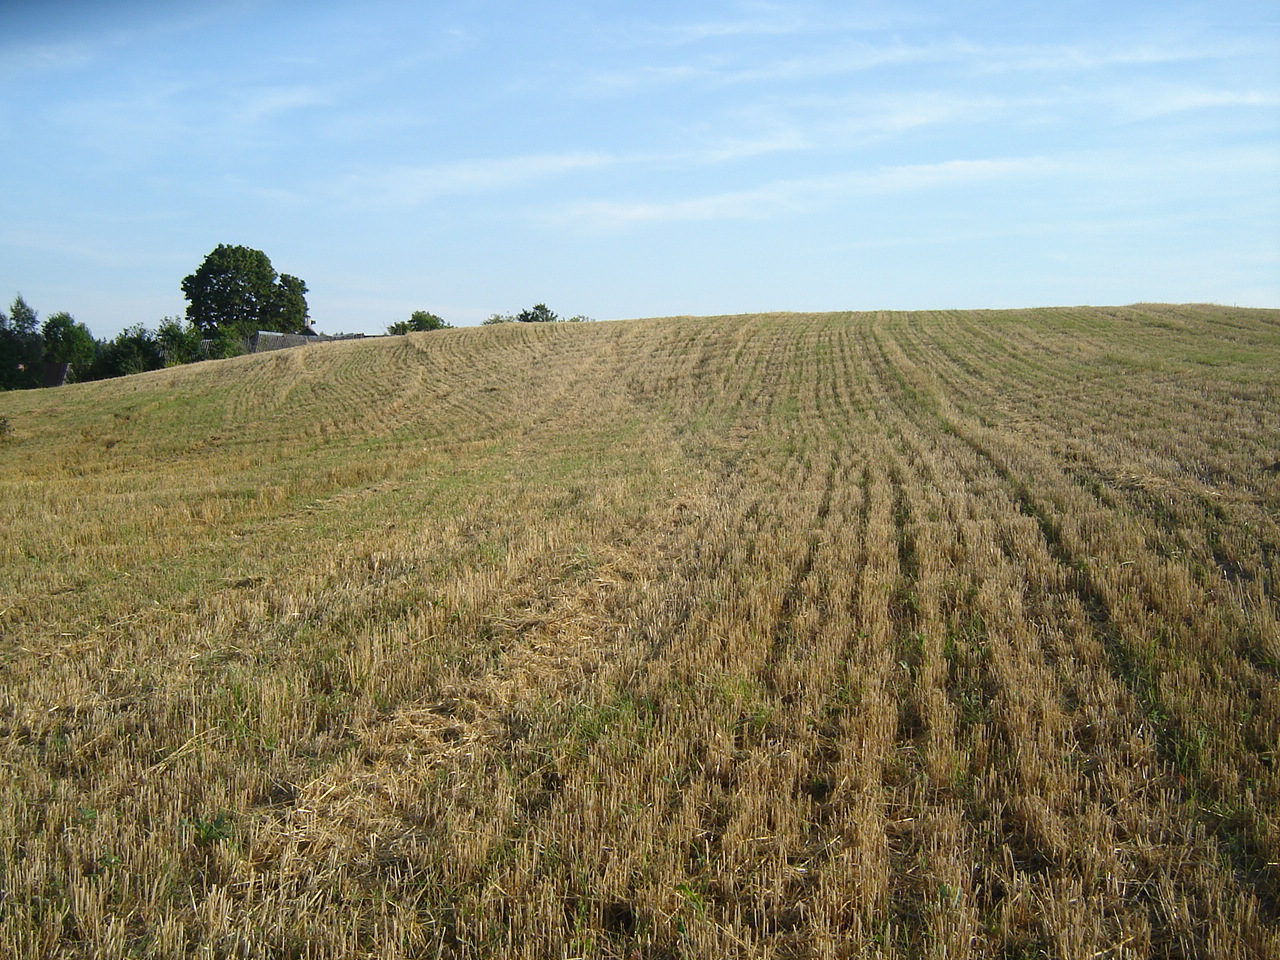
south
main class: Cropland
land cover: Barley
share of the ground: > 75 %
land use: Agriculture (excluding fallow land and kitchen gardens)
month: August
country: LT
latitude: 54.7134
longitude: 24.8412
